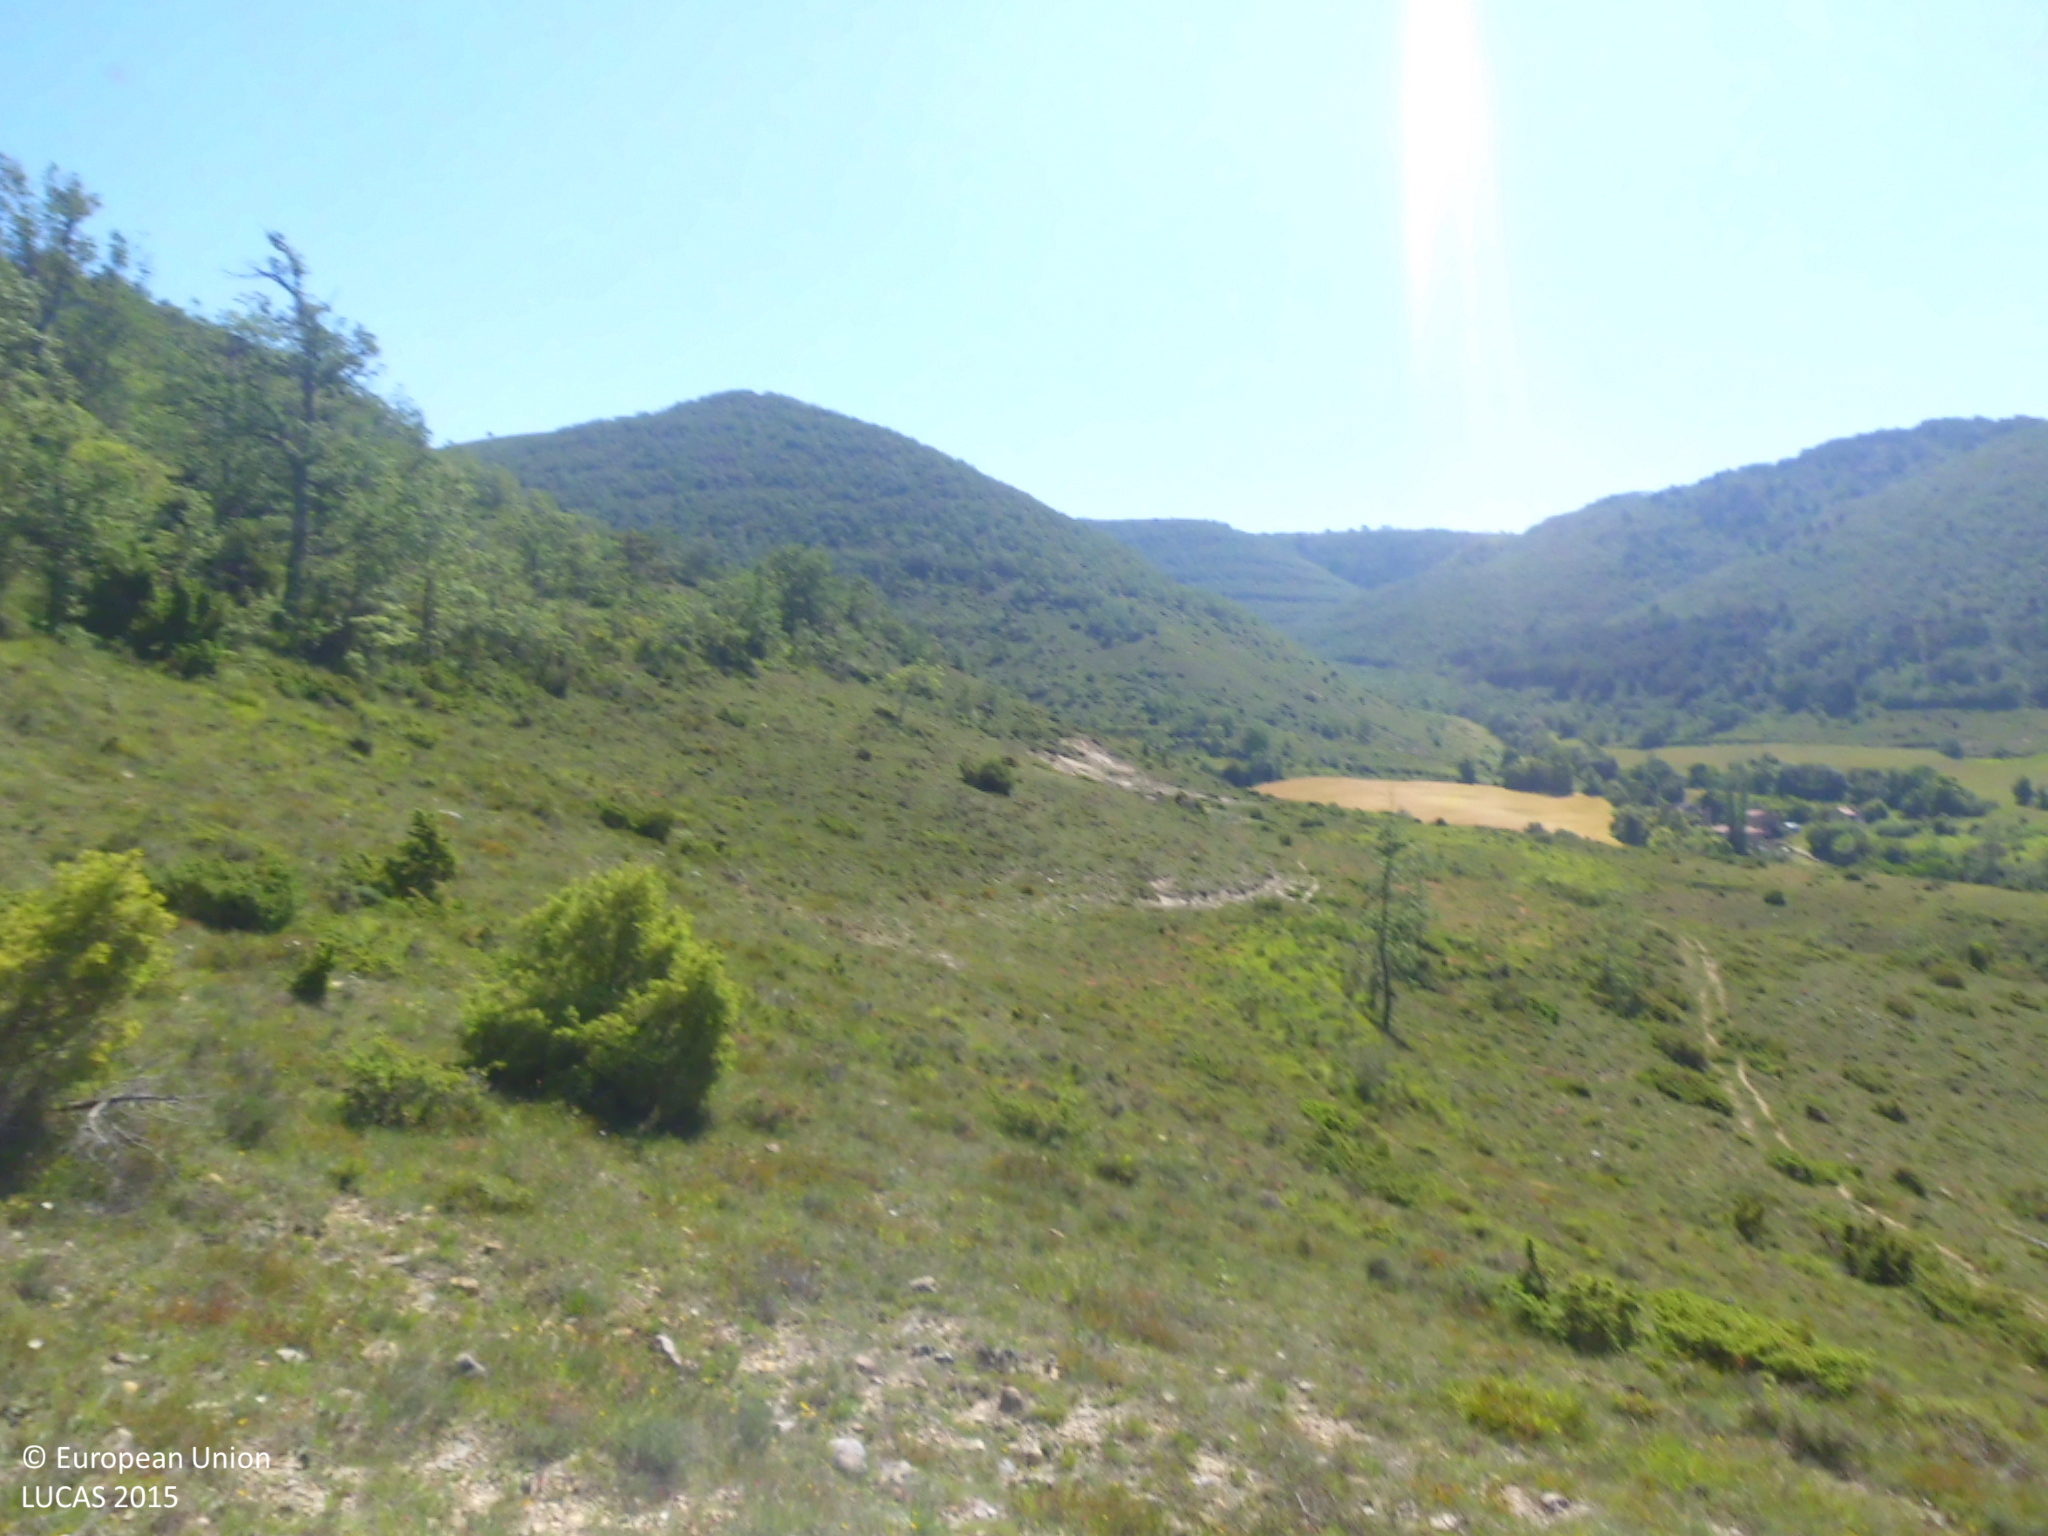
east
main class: Grassland
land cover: Grassland with sparse tree/shrub cover
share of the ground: > 75 %
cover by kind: herbaceous plants 85 %, broadleaved forest trees 5 %, shrubs 5 %, consolidated bare surface 5 %
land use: Agriculture (excluding fallow land and kitchen gardens)
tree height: < 5 m
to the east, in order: Grassland with sparse tree/shrub cover; Other bare soil
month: June
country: ES
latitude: 42.9073
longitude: -3.4253
